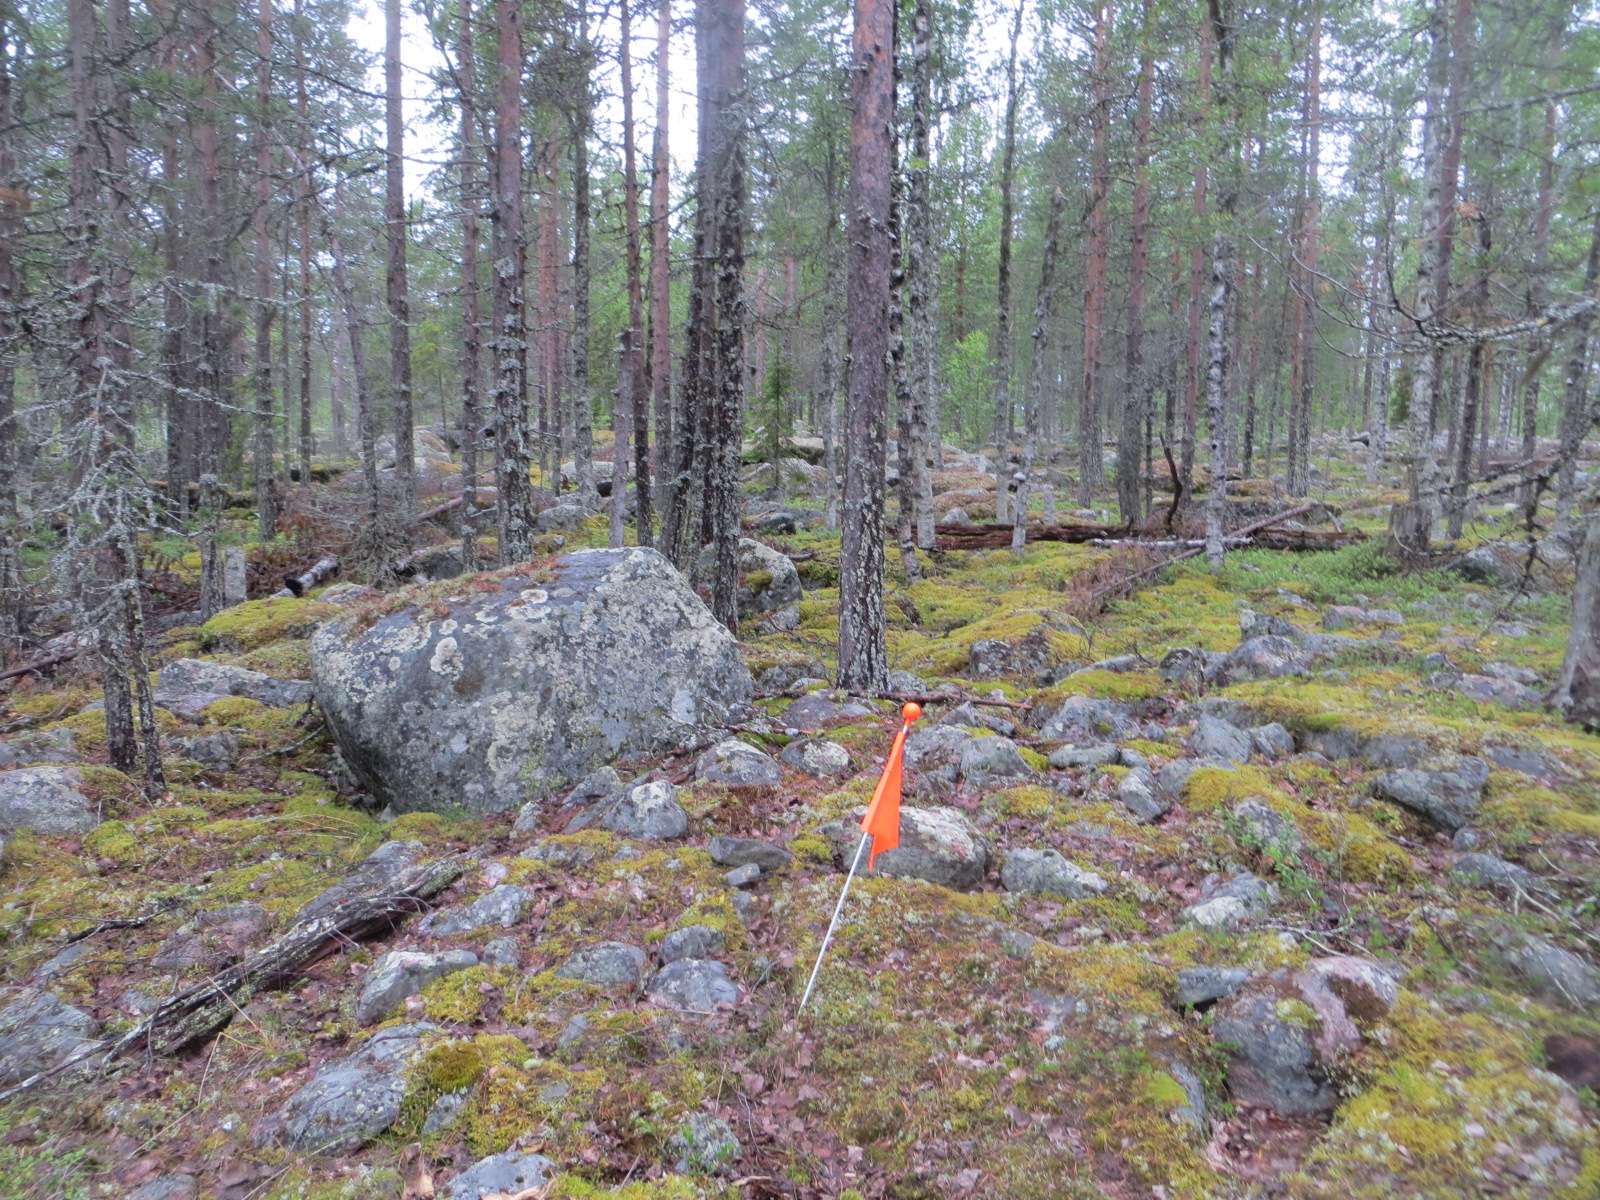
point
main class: Woodland
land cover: Pine dominated mixed woodland
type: boreal forest
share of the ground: 50 - 75 %
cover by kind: coniferous forest trees 40 %, broadleaved forest trees 30 %, shrubs 20 %, unconsolidated bare surface 10 %
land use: Forestry
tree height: > 5 m
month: July
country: FI
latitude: 66.5139
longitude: 24.5033
